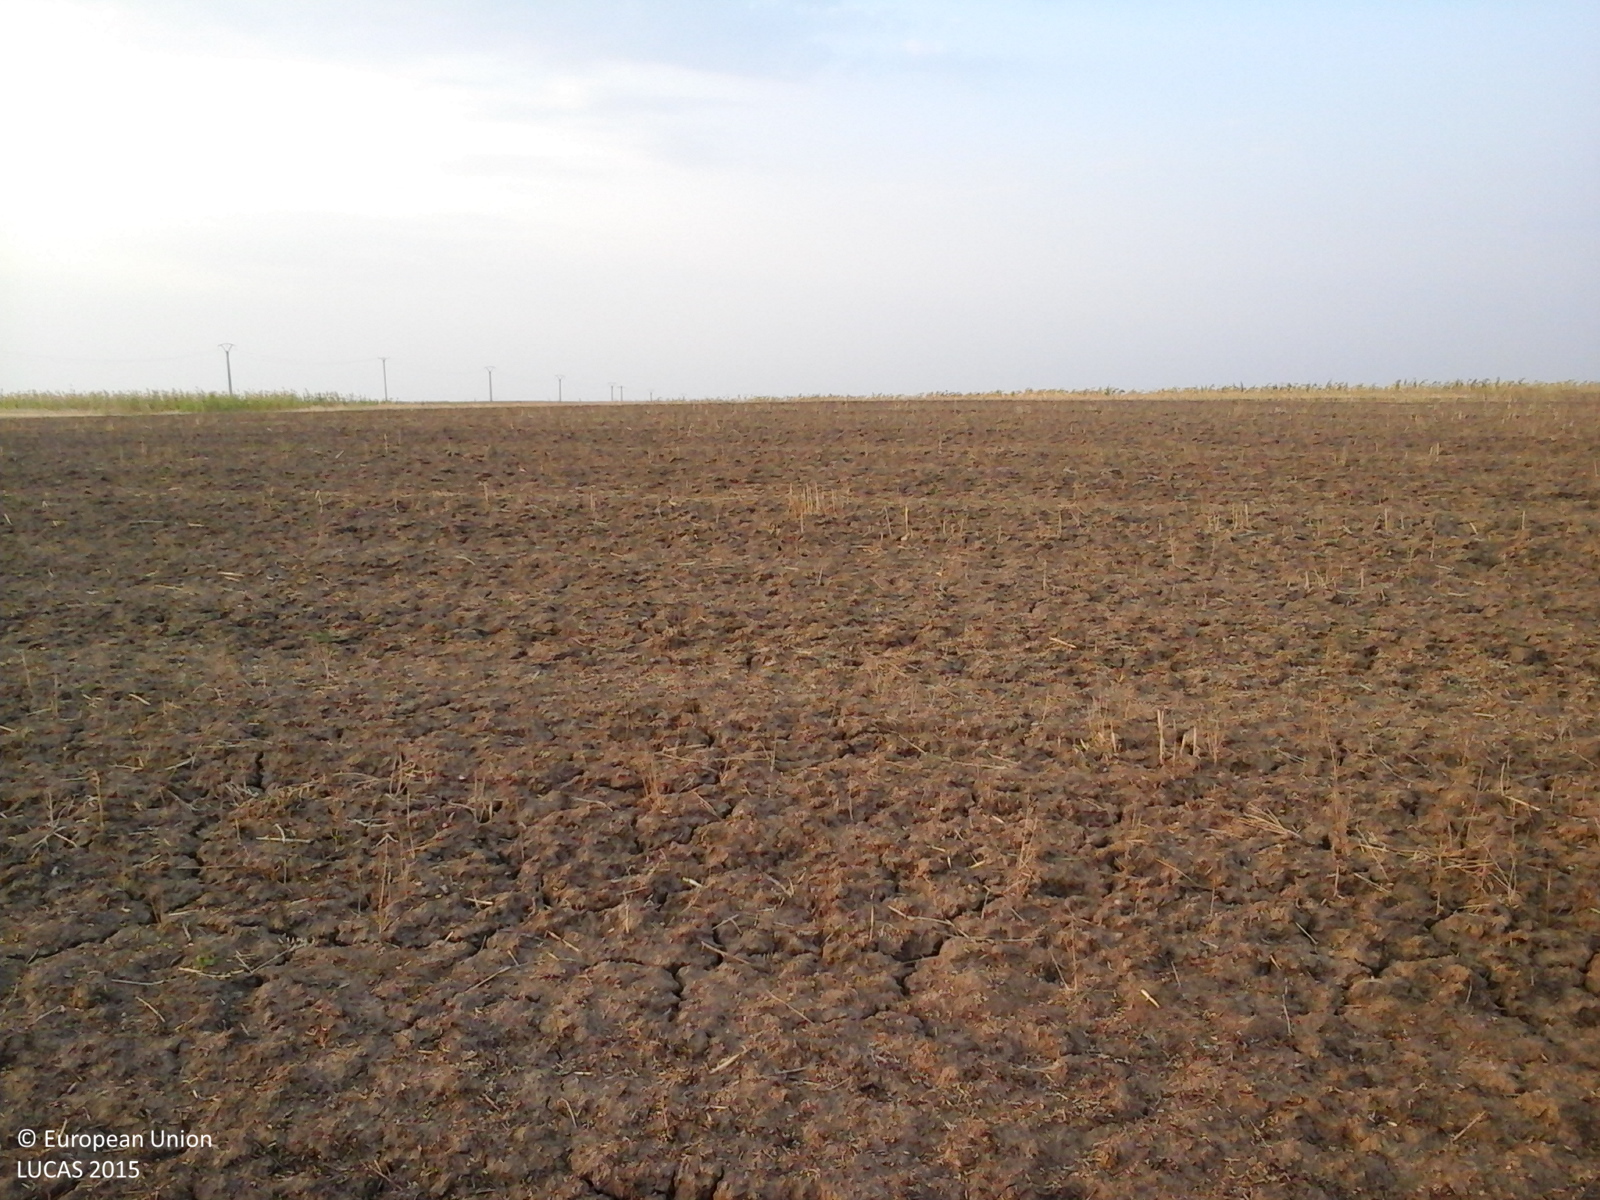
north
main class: Cropland
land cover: Common wheat
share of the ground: < 10 %
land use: Agriculture (excluding fallow land and kitchen gardens)
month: August
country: RO
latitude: 44.4143
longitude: 23.0691
